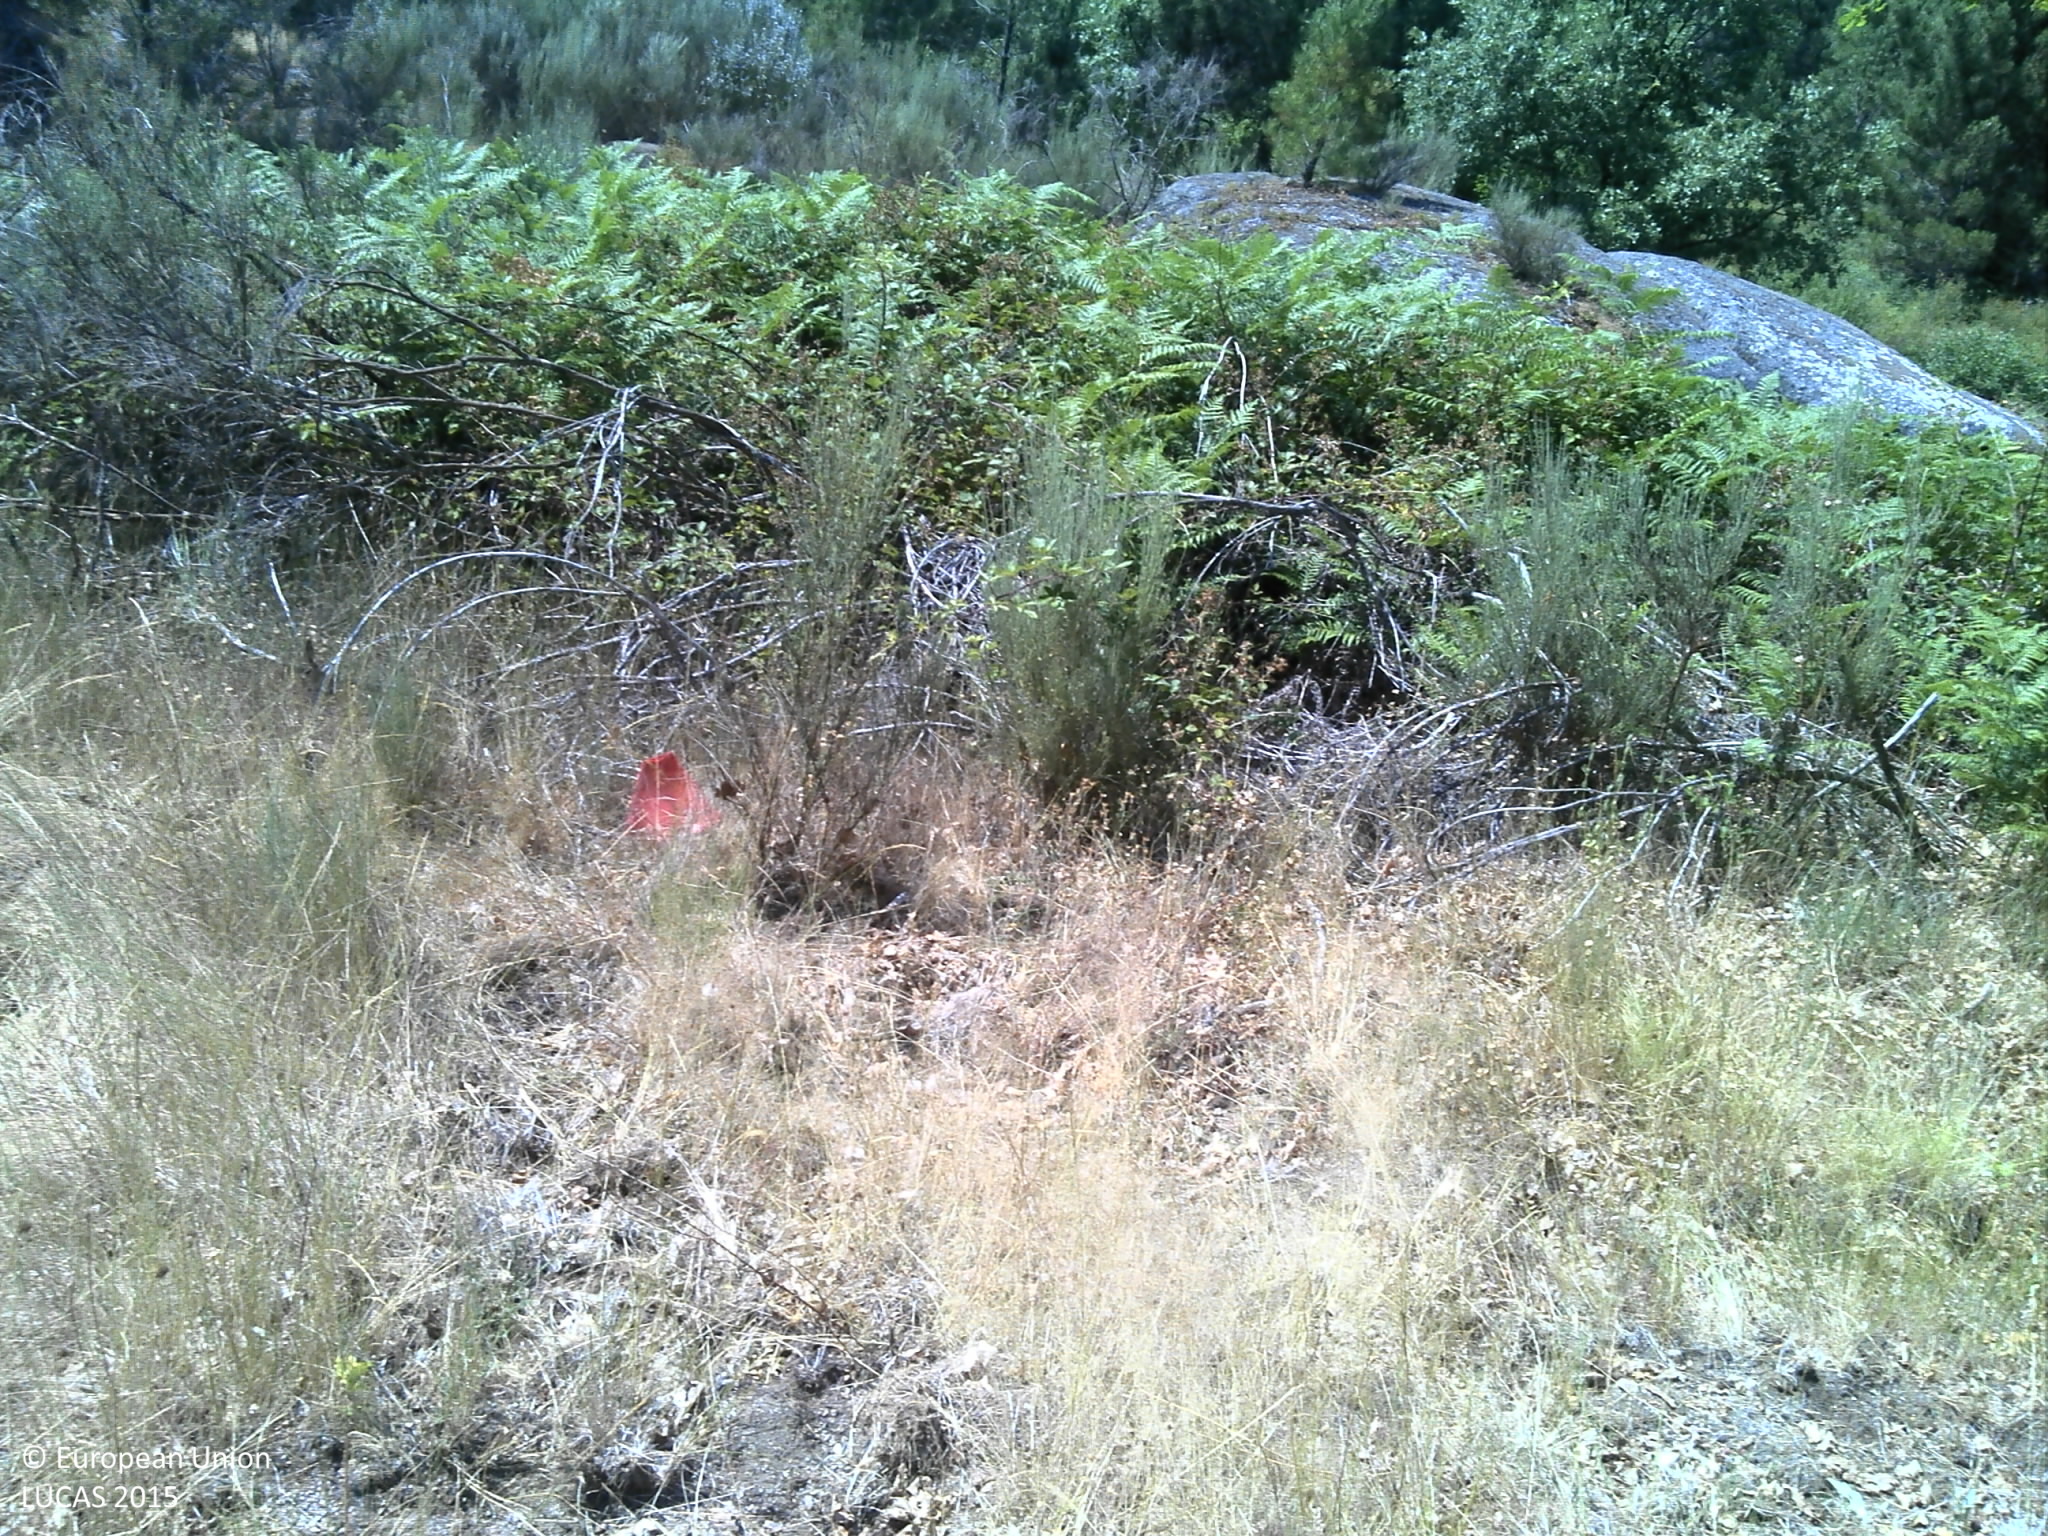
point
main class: Shrubland
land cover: Shrubland with sparse tree cover
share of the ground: 50 - 75 %
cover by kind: shrubs 50 %, herbaceous plants 20 %, consolidated bare surface 20 %, broadleaved forest trees 5 %, unconsolidated bare surface 5 %
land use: Semi-natural and natural areas not in use
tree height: > 5 m
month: July
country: PT
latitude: 40.8246
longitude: -7.5841
